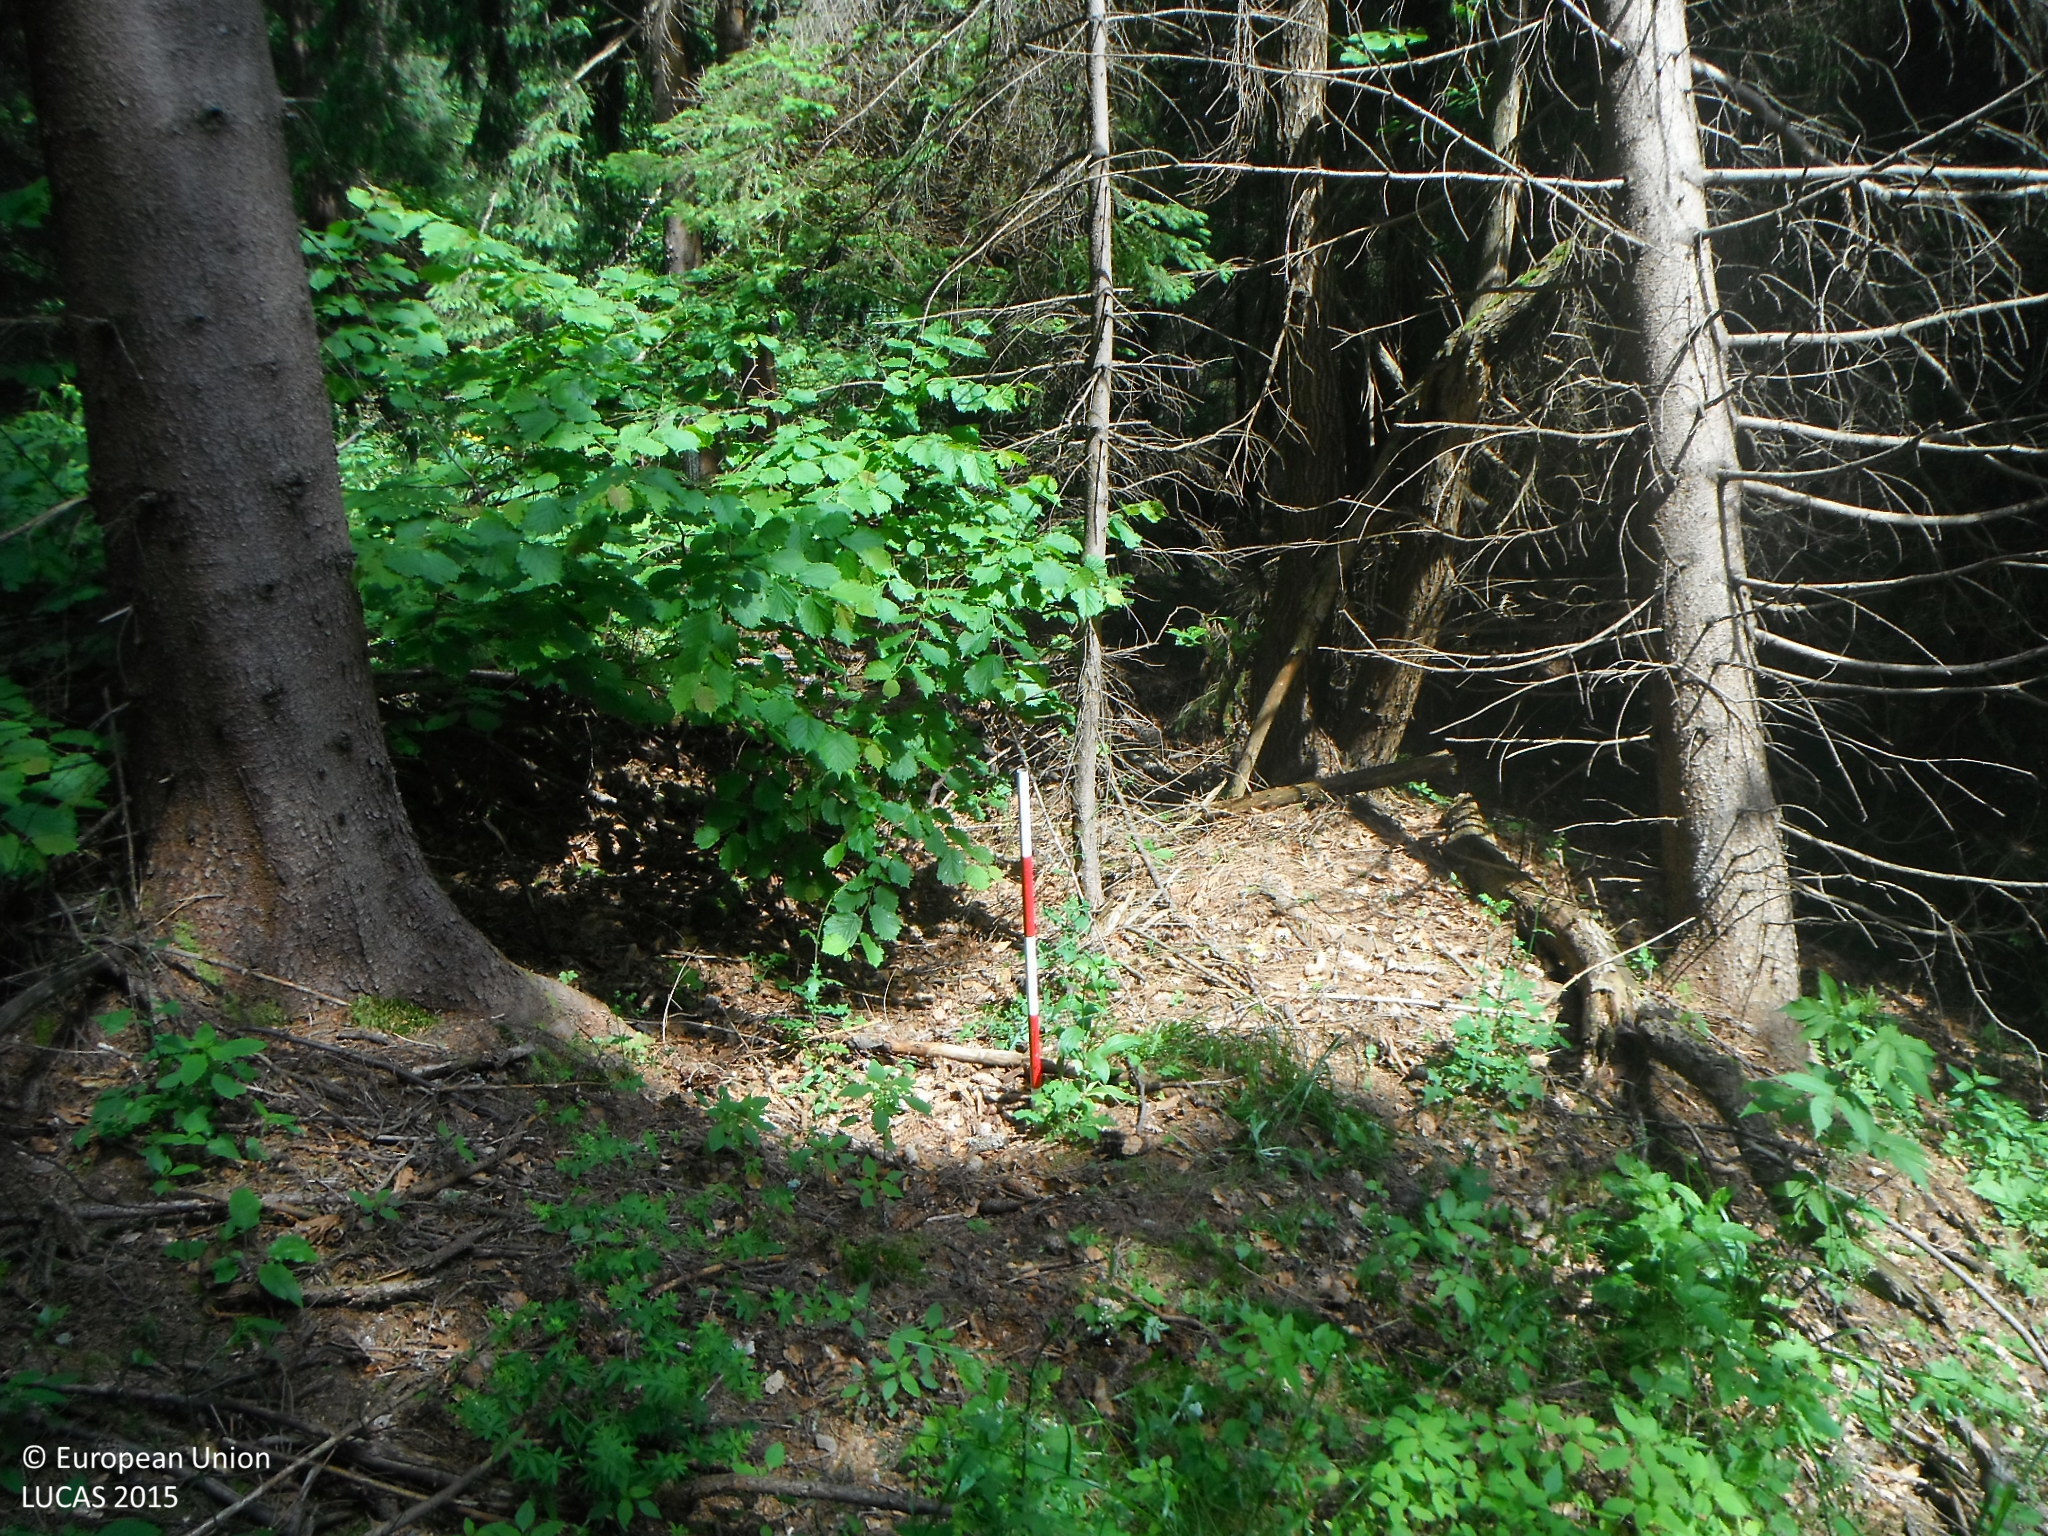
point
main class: Woodland
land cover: Spruce dominated mixed woodland
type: hemiboreal forest and nemoral coniferous forest and mixed broadleaved-coniferous forest
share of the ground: > 75 %
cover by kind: coniferous forest trees 65 %, broadleaved forest trees 25 %, herbaceous plants 10 %
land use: Forestry
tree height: > 5 m
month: June
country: SK
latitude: 49.2621
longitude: 19.4940
